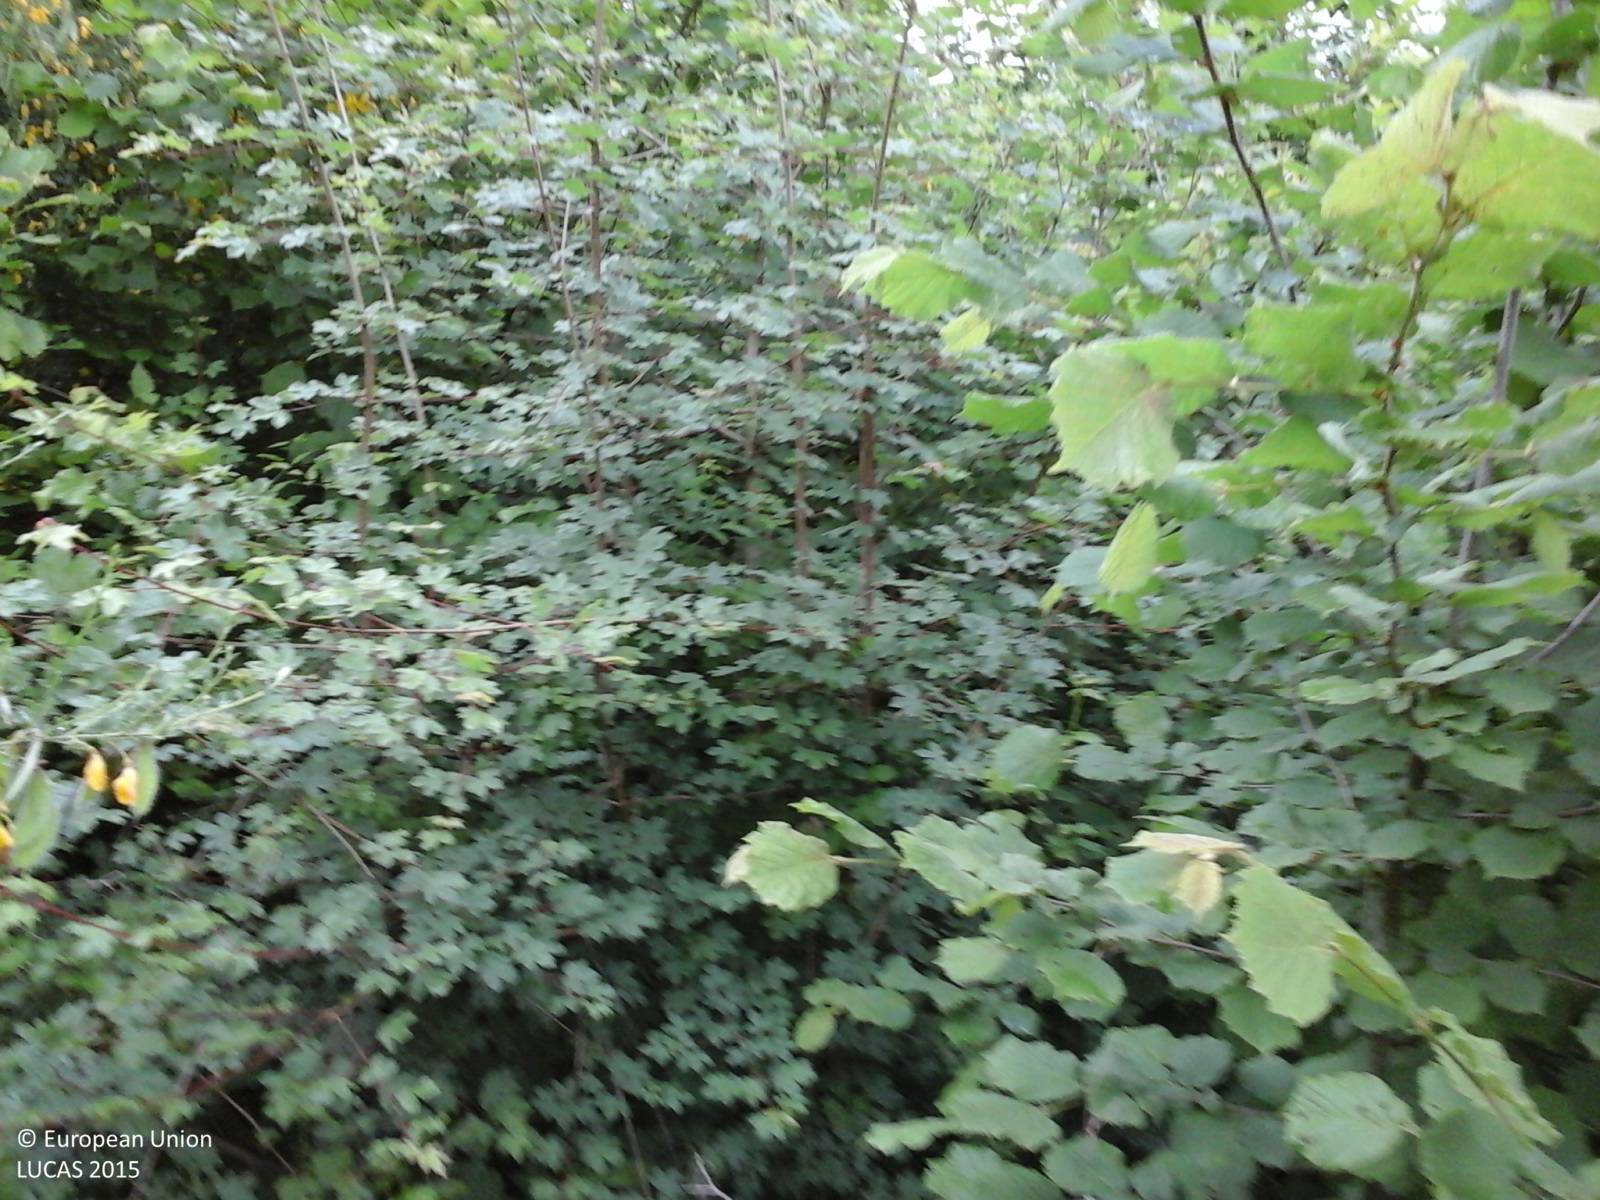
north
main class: Woodland
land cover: Broadleaved woodland
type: thermophilous deciduous forest
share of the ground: > 75 %
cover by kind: broadleaved forest trees 100 %
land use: Forestry
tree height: > 5 m
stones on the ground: < 10 %
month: May
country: IT
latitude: 42.3402
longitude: 12.2377
